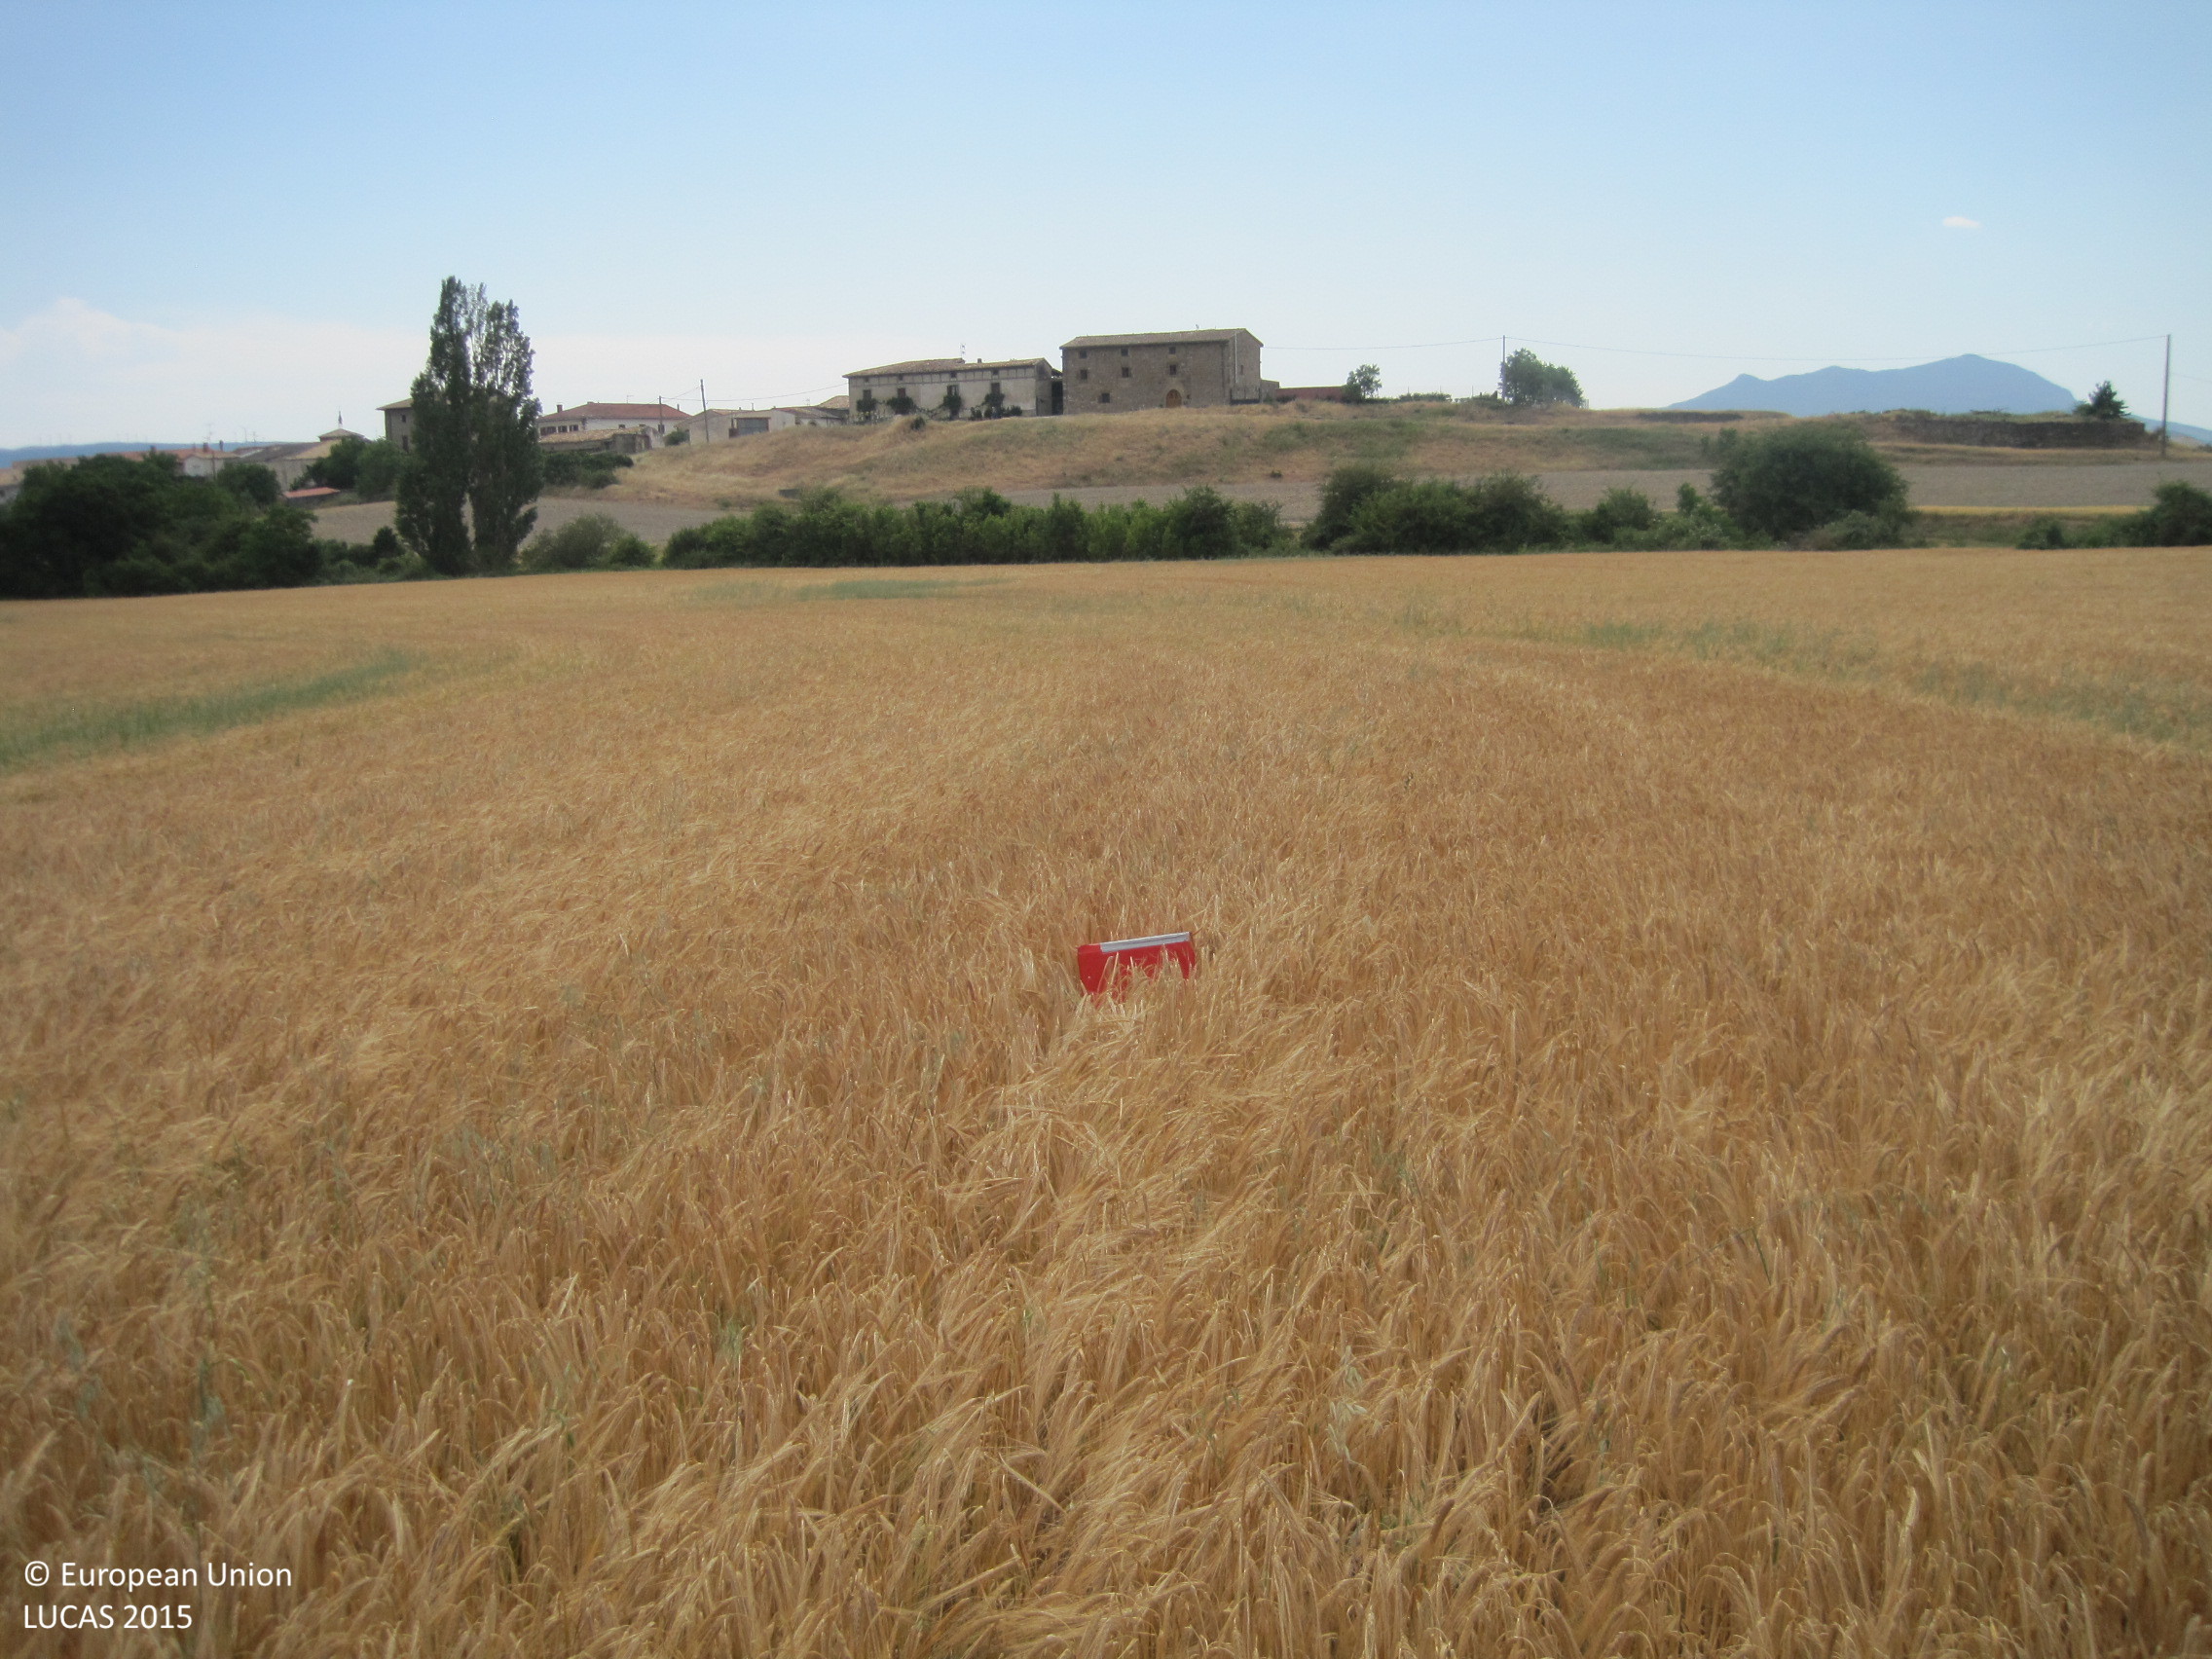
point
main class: Cropland
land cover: Barley
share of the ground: > 75 %
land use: Agriculture (excluding fallow land and kitchen gardens)
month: June
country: ES
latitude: 42.6810
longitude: -1.2493
